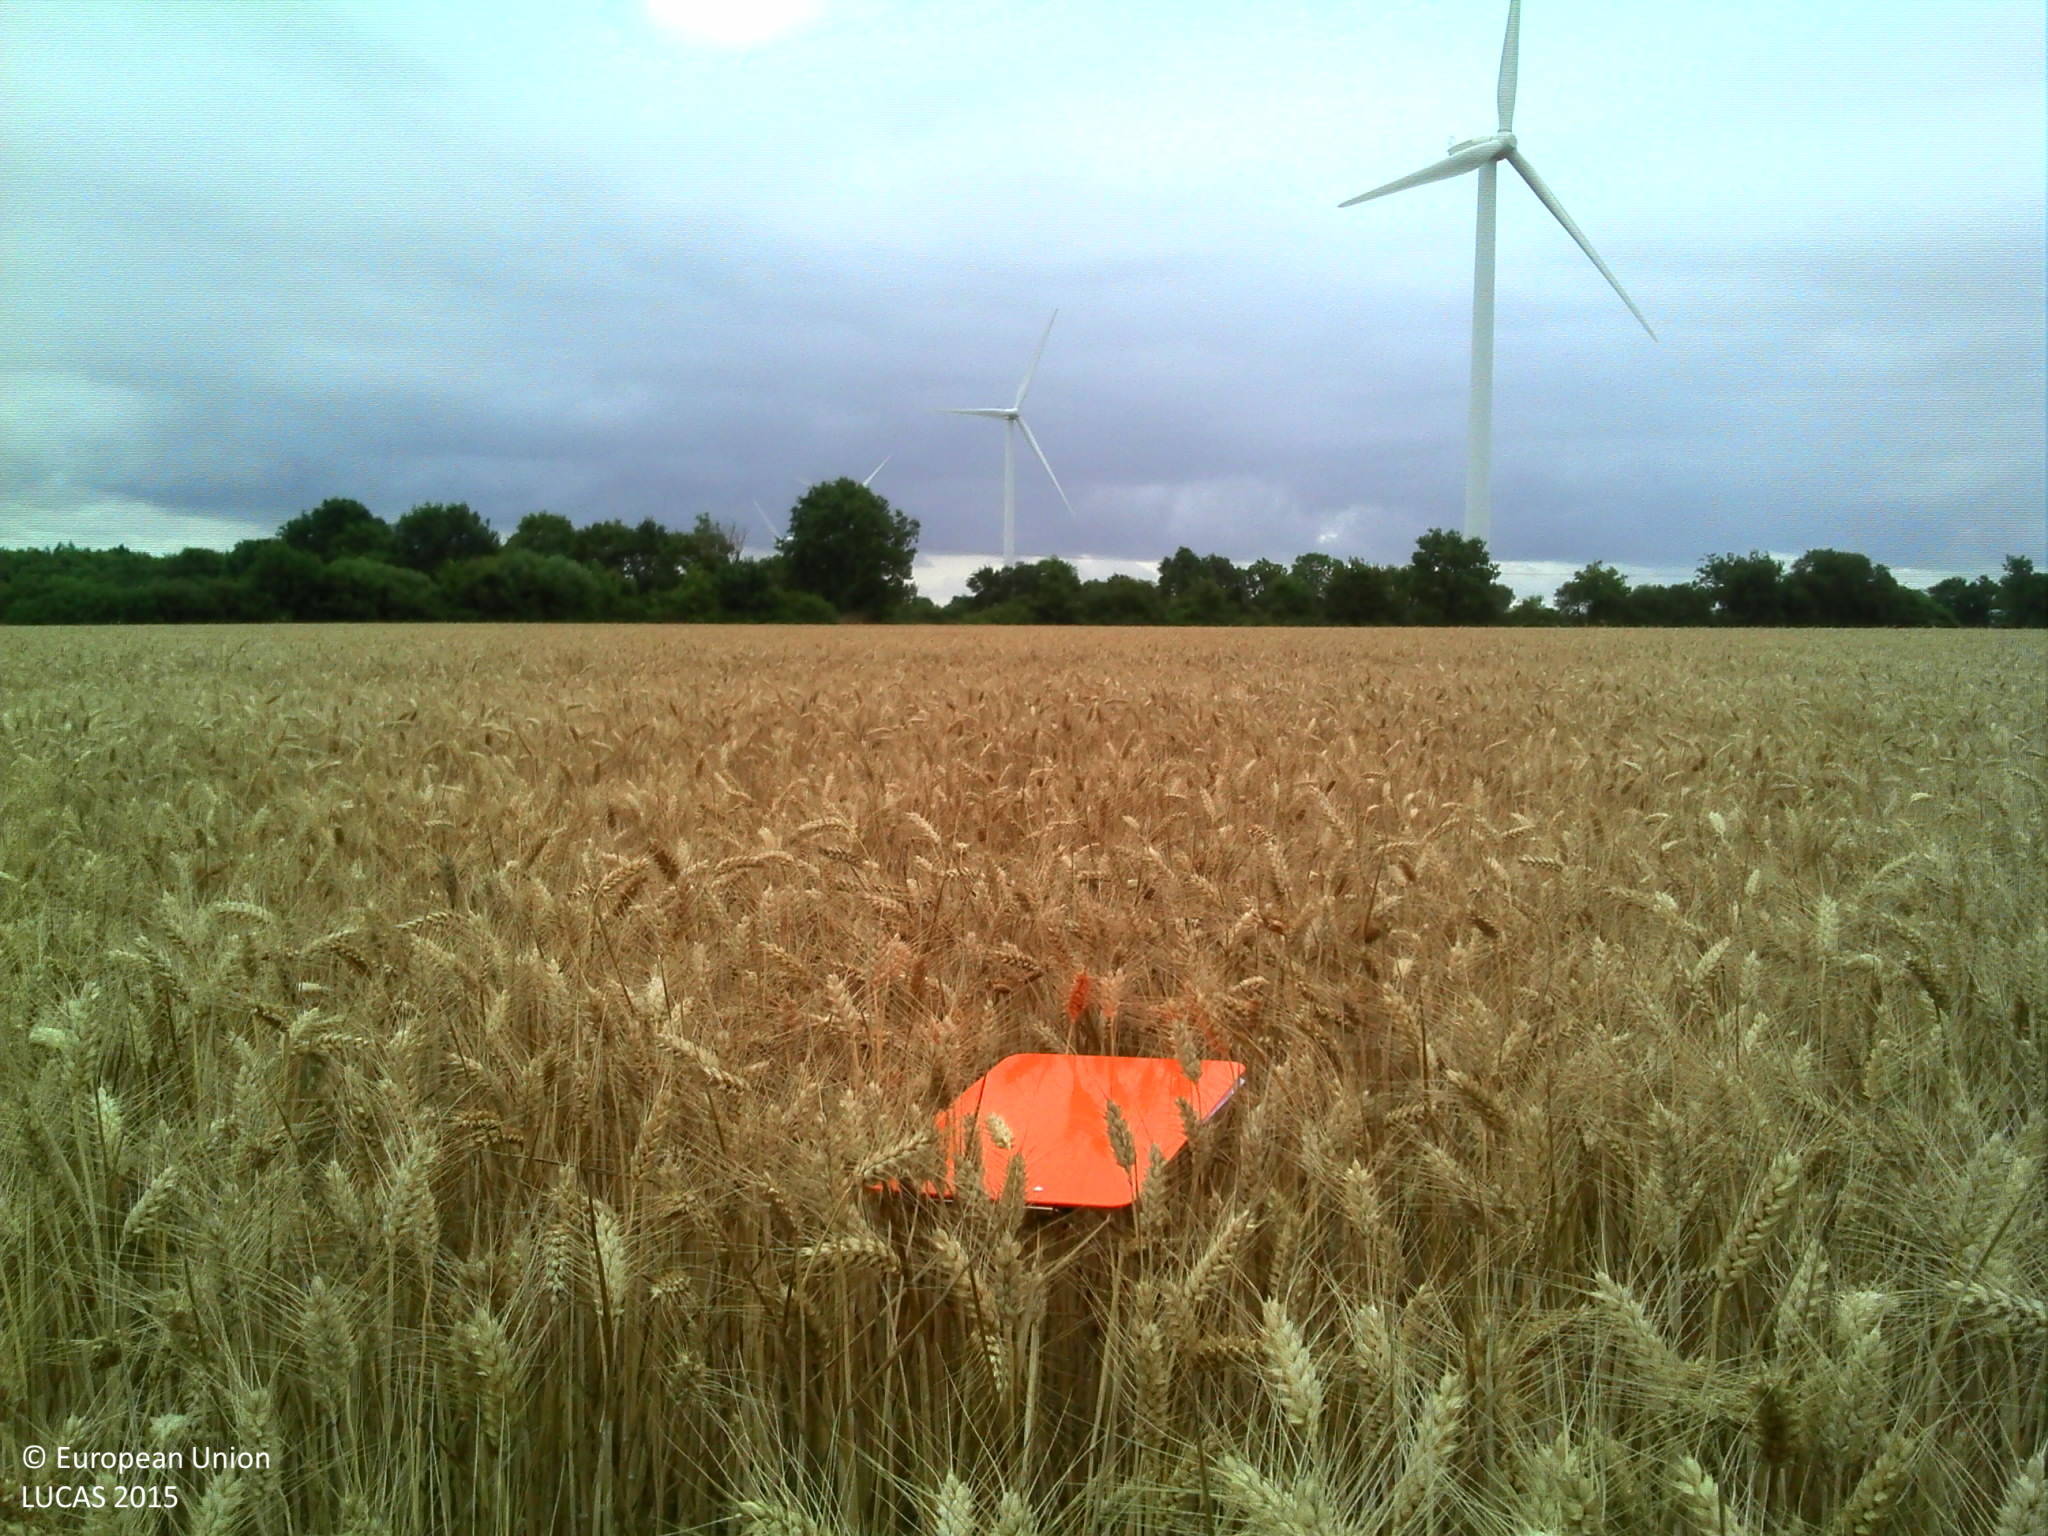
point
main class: Cropland
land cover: Common wheat
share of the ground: > 75 %
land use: Agriculture (excluding fallow land and kitchen gardens)
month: July
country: FR
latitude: 46.9973
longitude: -1.7075
